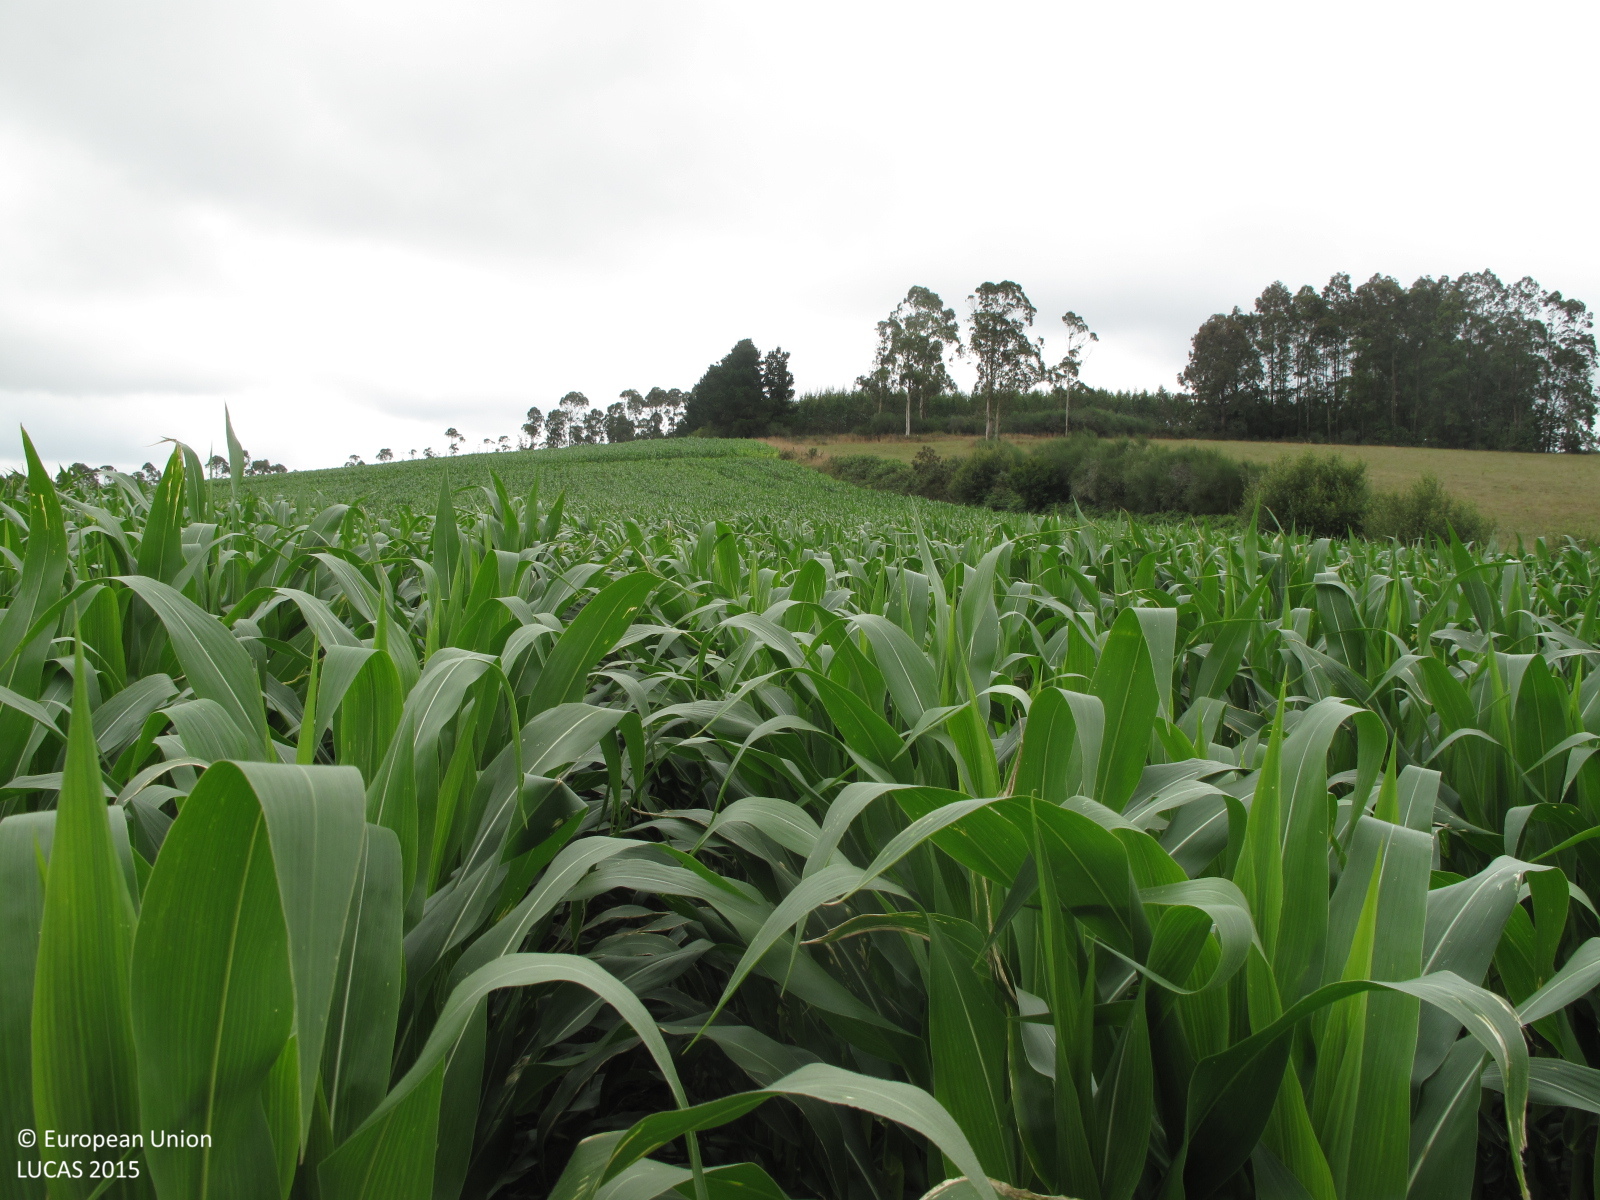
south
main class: Cropland
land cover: Maize
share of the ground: > 75 %
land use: Agriculture (excluding fallow land and kitchen gardens)
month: July
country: ES
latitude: 43.0989
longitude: -8.1695
